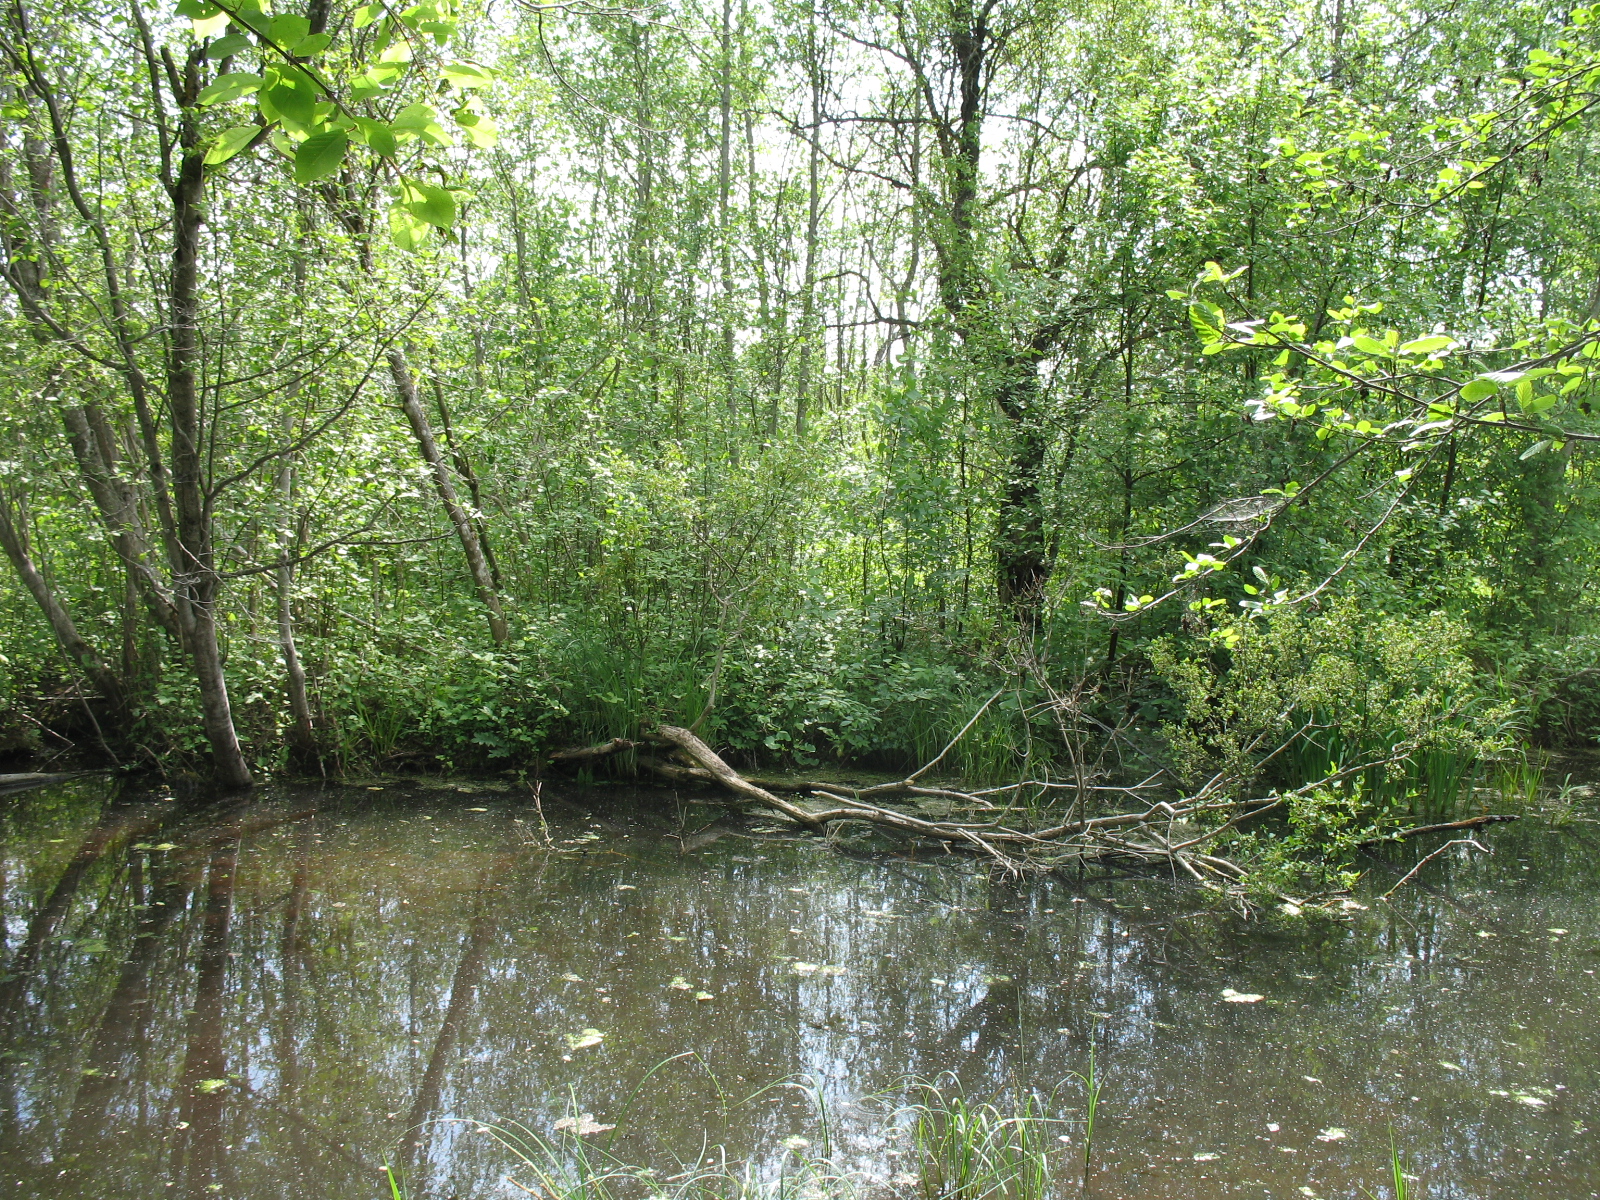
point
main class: Woodland
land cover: Broadleaved woodland
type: floodplain forest
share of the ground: > 75 %
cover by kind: broadleaved forest trees 95 %, herbaceous plants 5 %
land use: Forestry
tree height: > 5 m
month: May
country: LV
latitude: 56.8331
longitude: 23.5633
